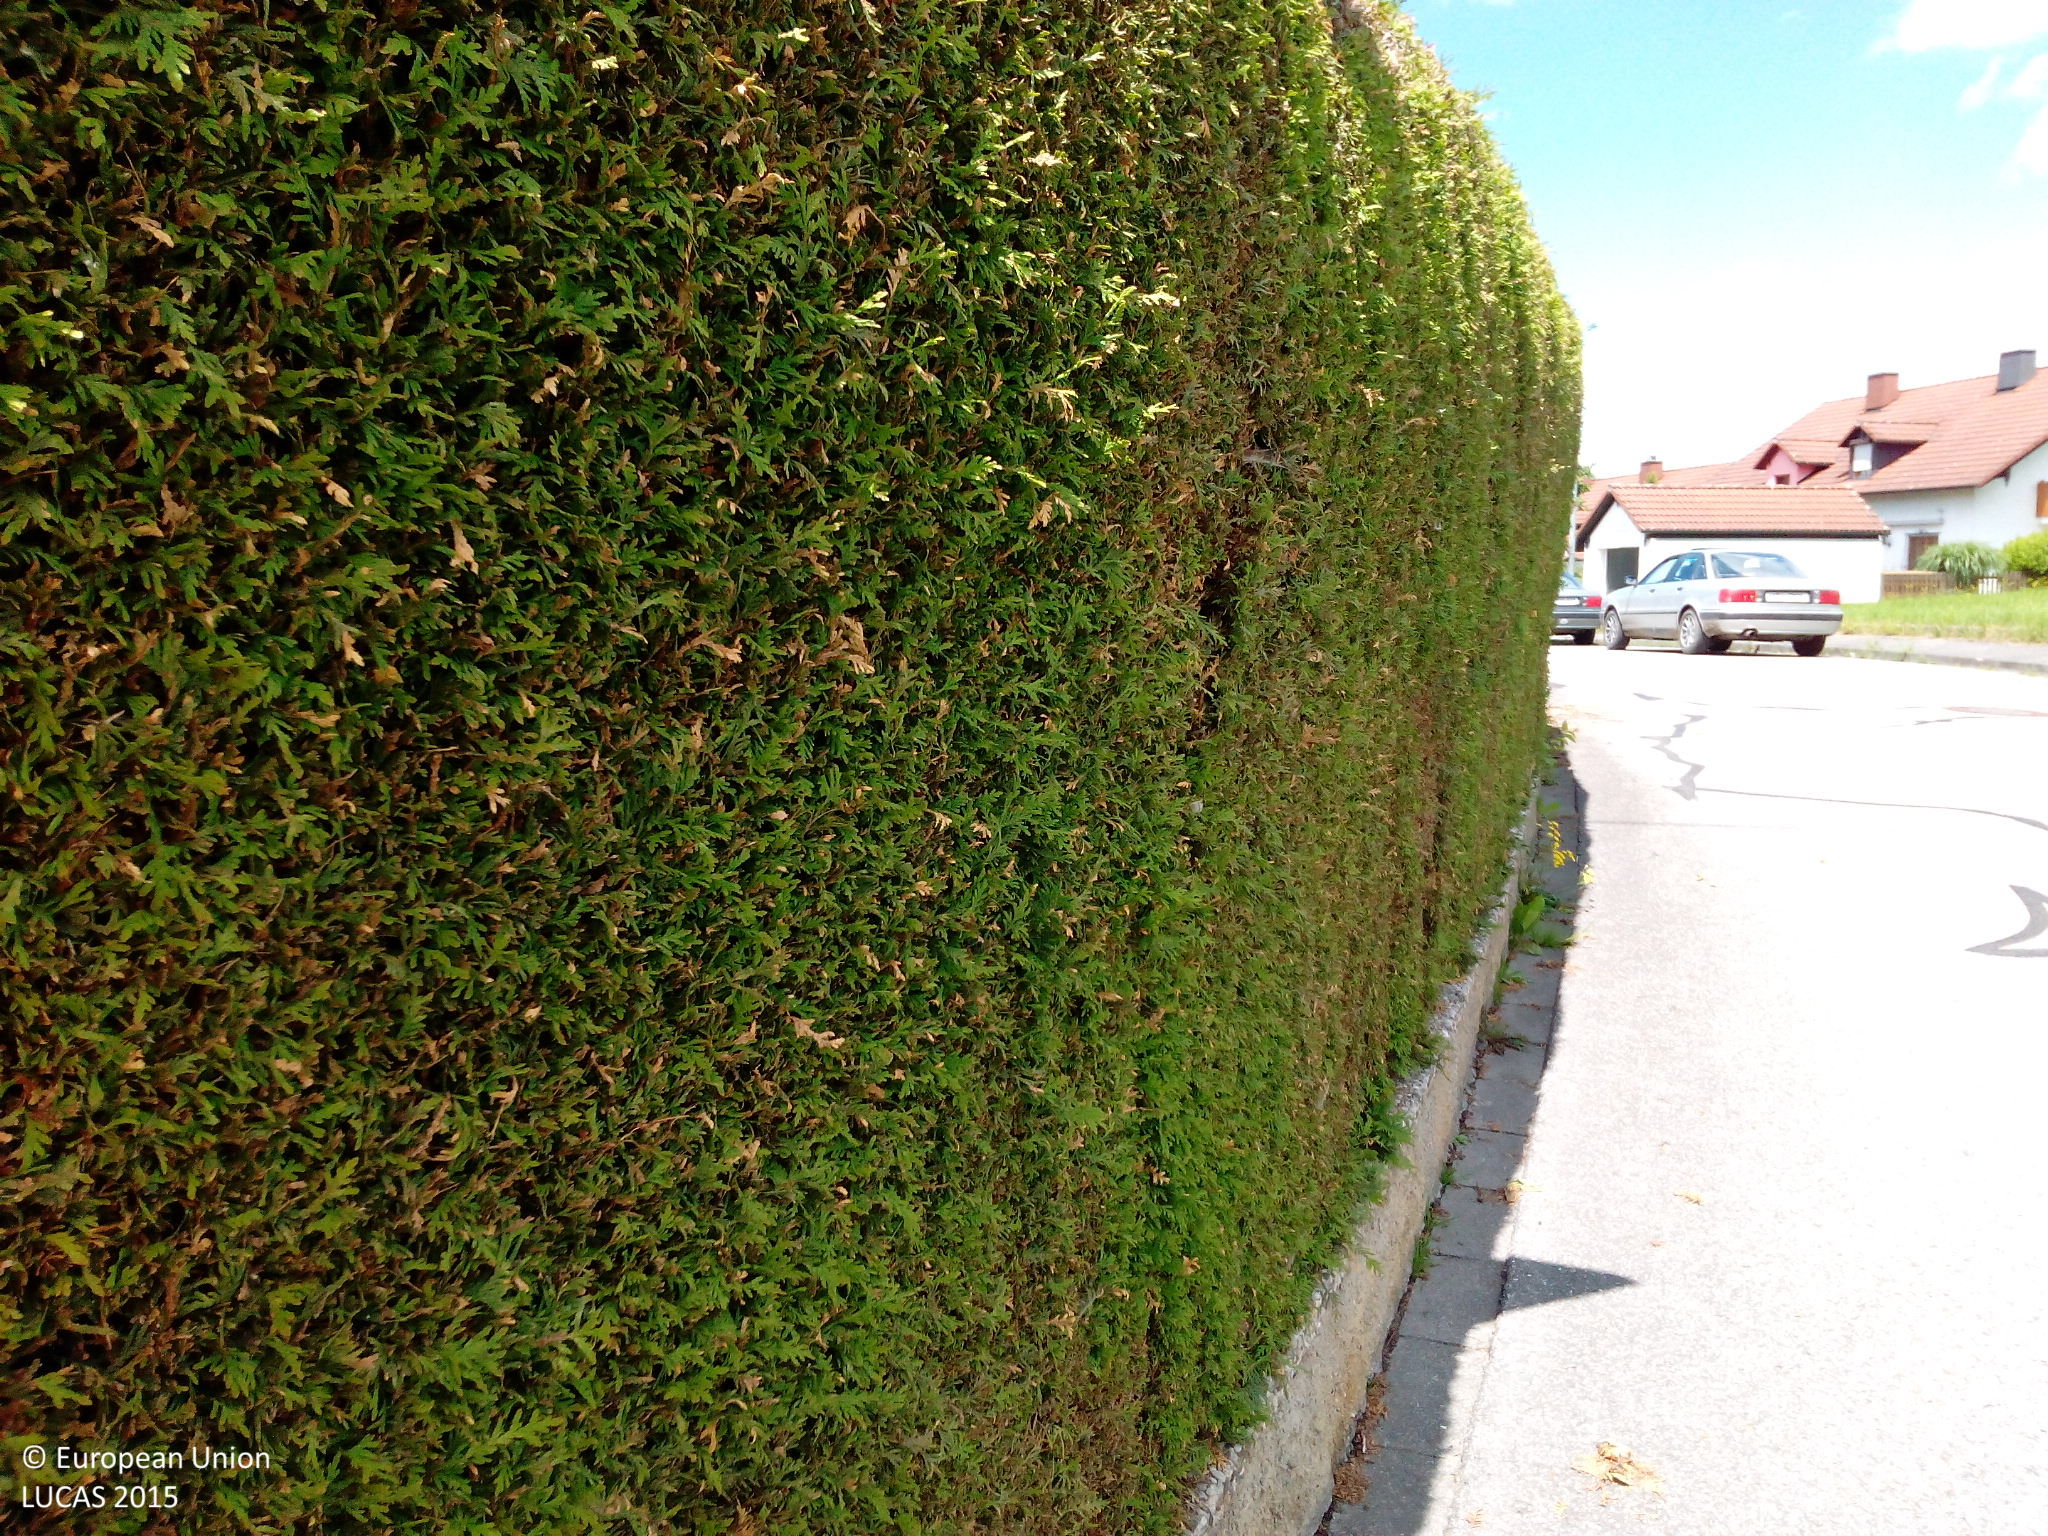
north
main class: Grassland
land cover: Grassland without tree/shrub cover
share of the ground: > 75 %
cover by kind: herbaceous plants 100 %
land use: Residential
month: June
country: DE
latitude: 48.3058
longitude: 12.3854
